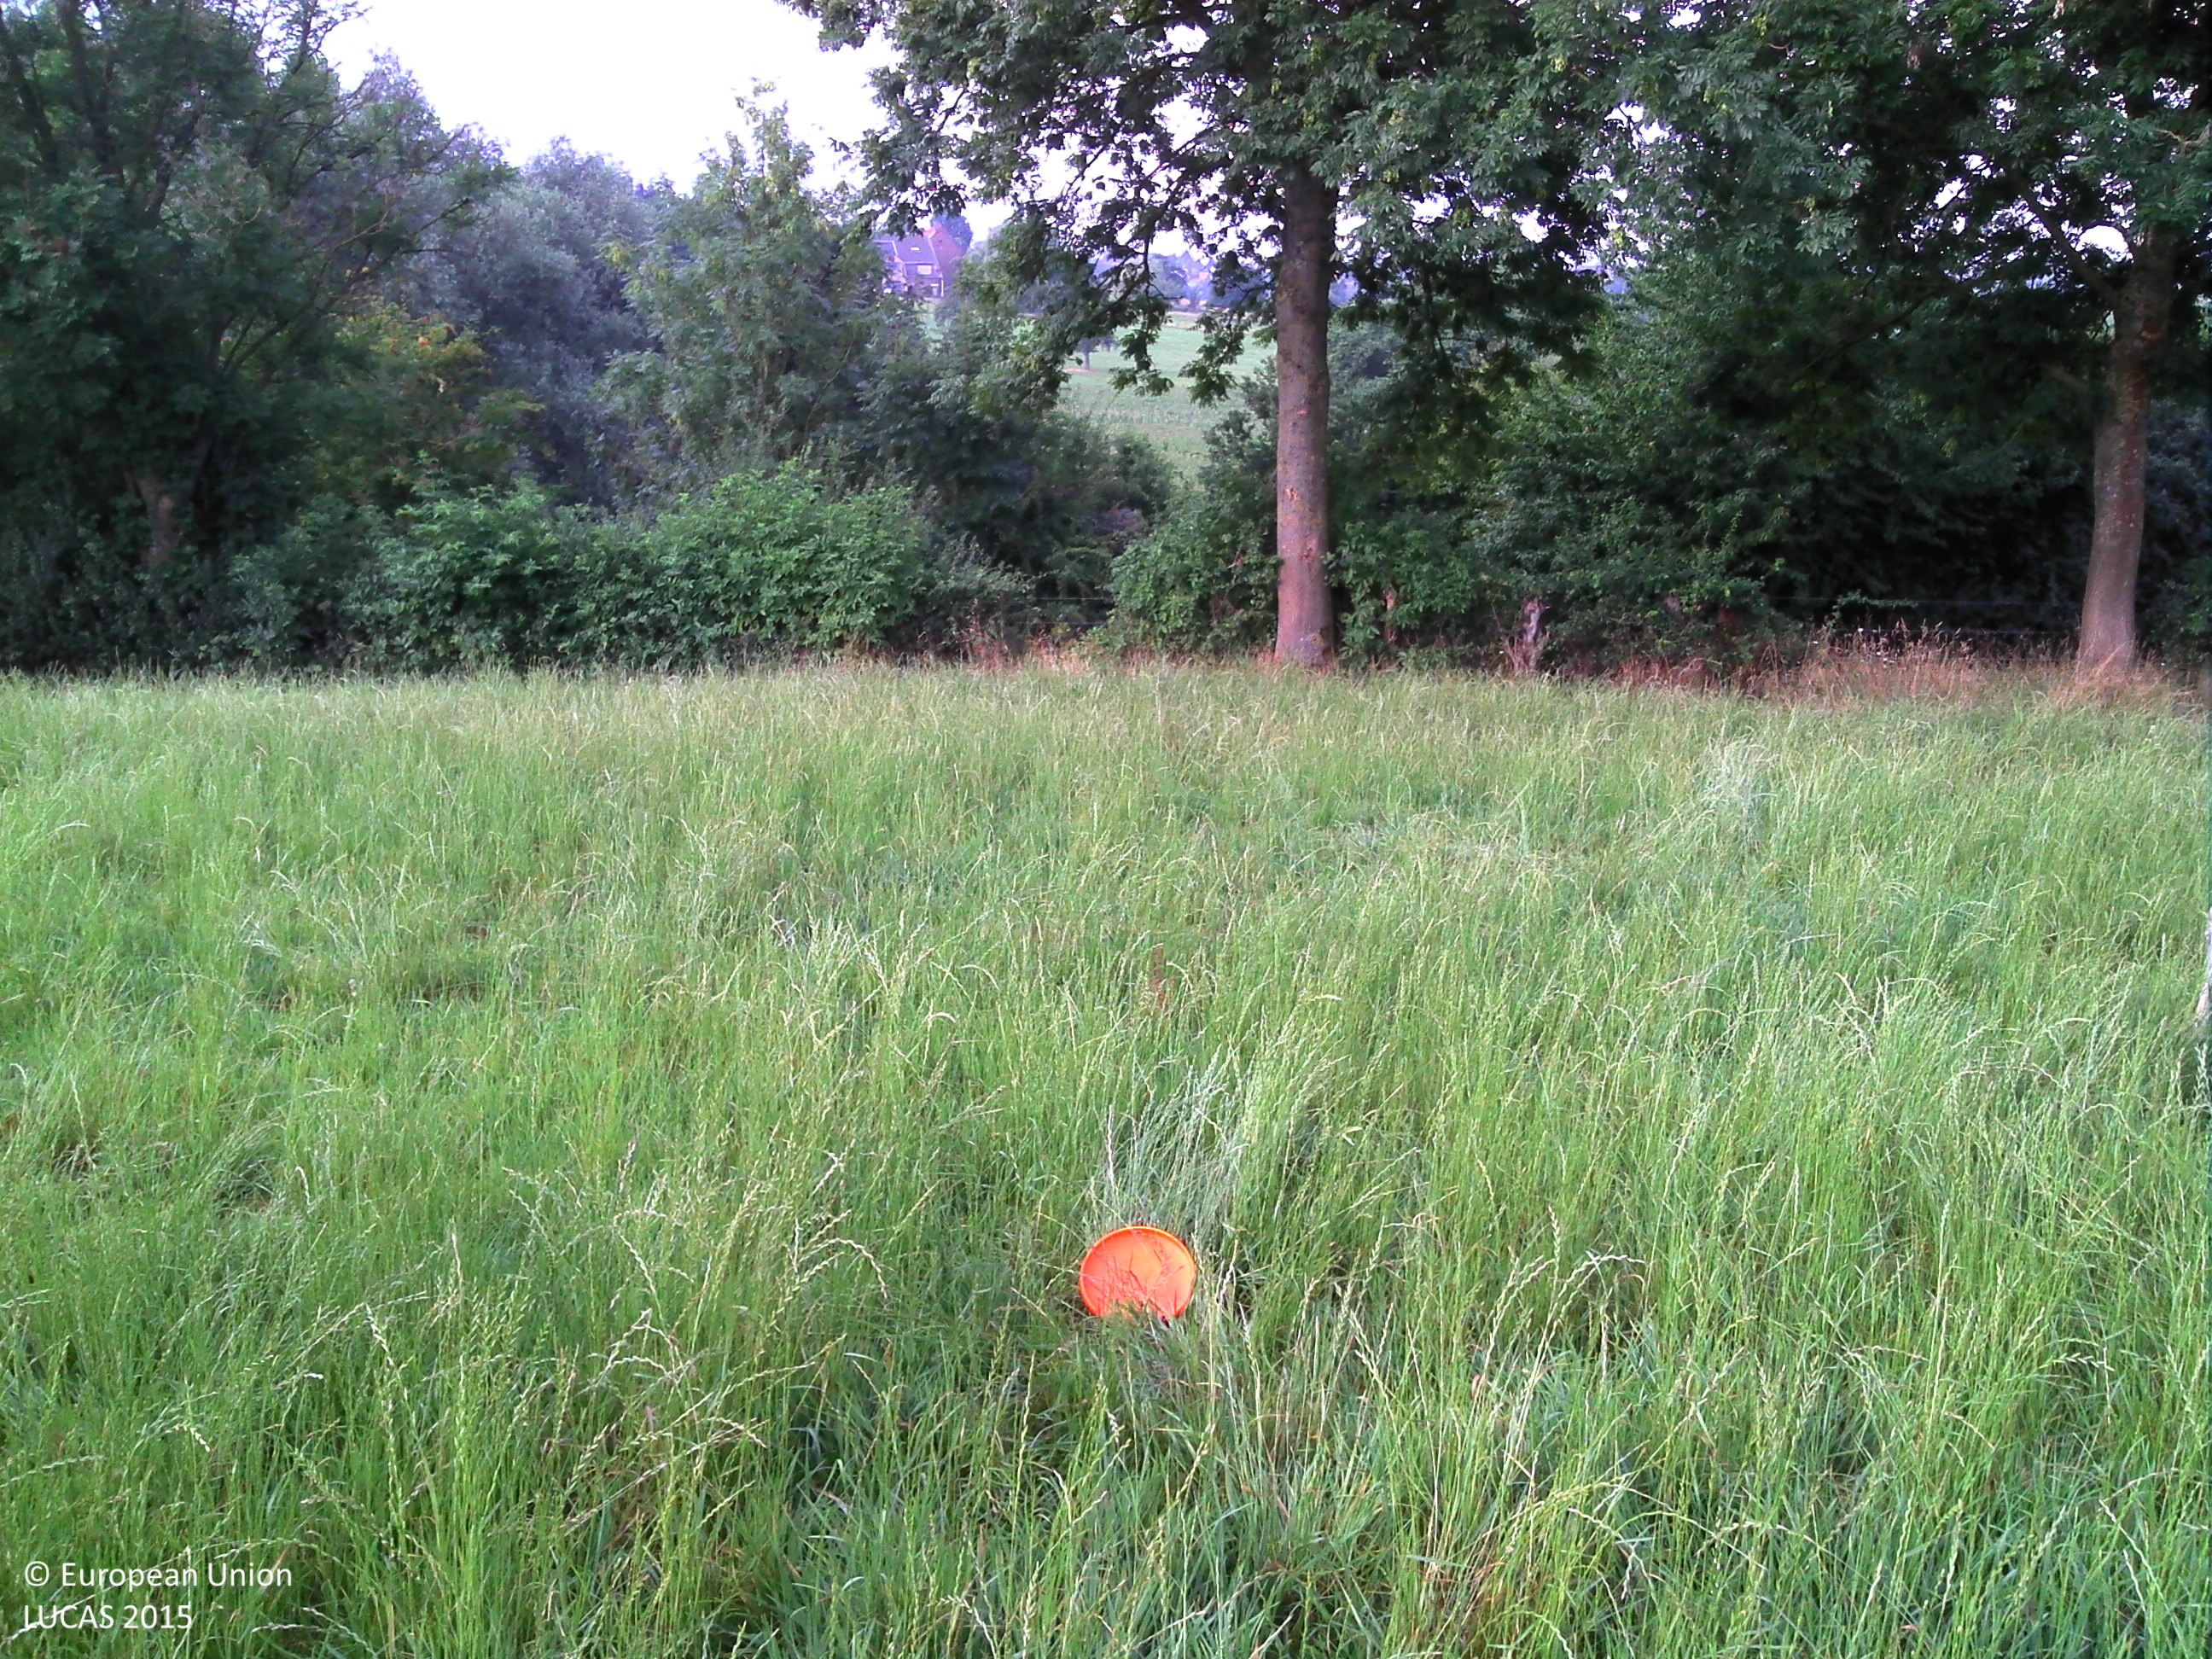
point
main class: Grassland
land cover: Grassland without tree/shrub cover
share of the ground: > 75 %
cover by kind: herbaceous plants 100 %
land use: Agriculture (excluding fallow land and kitchen gardens)
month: July
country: BE
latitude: 50.6808
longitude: 5.7387
